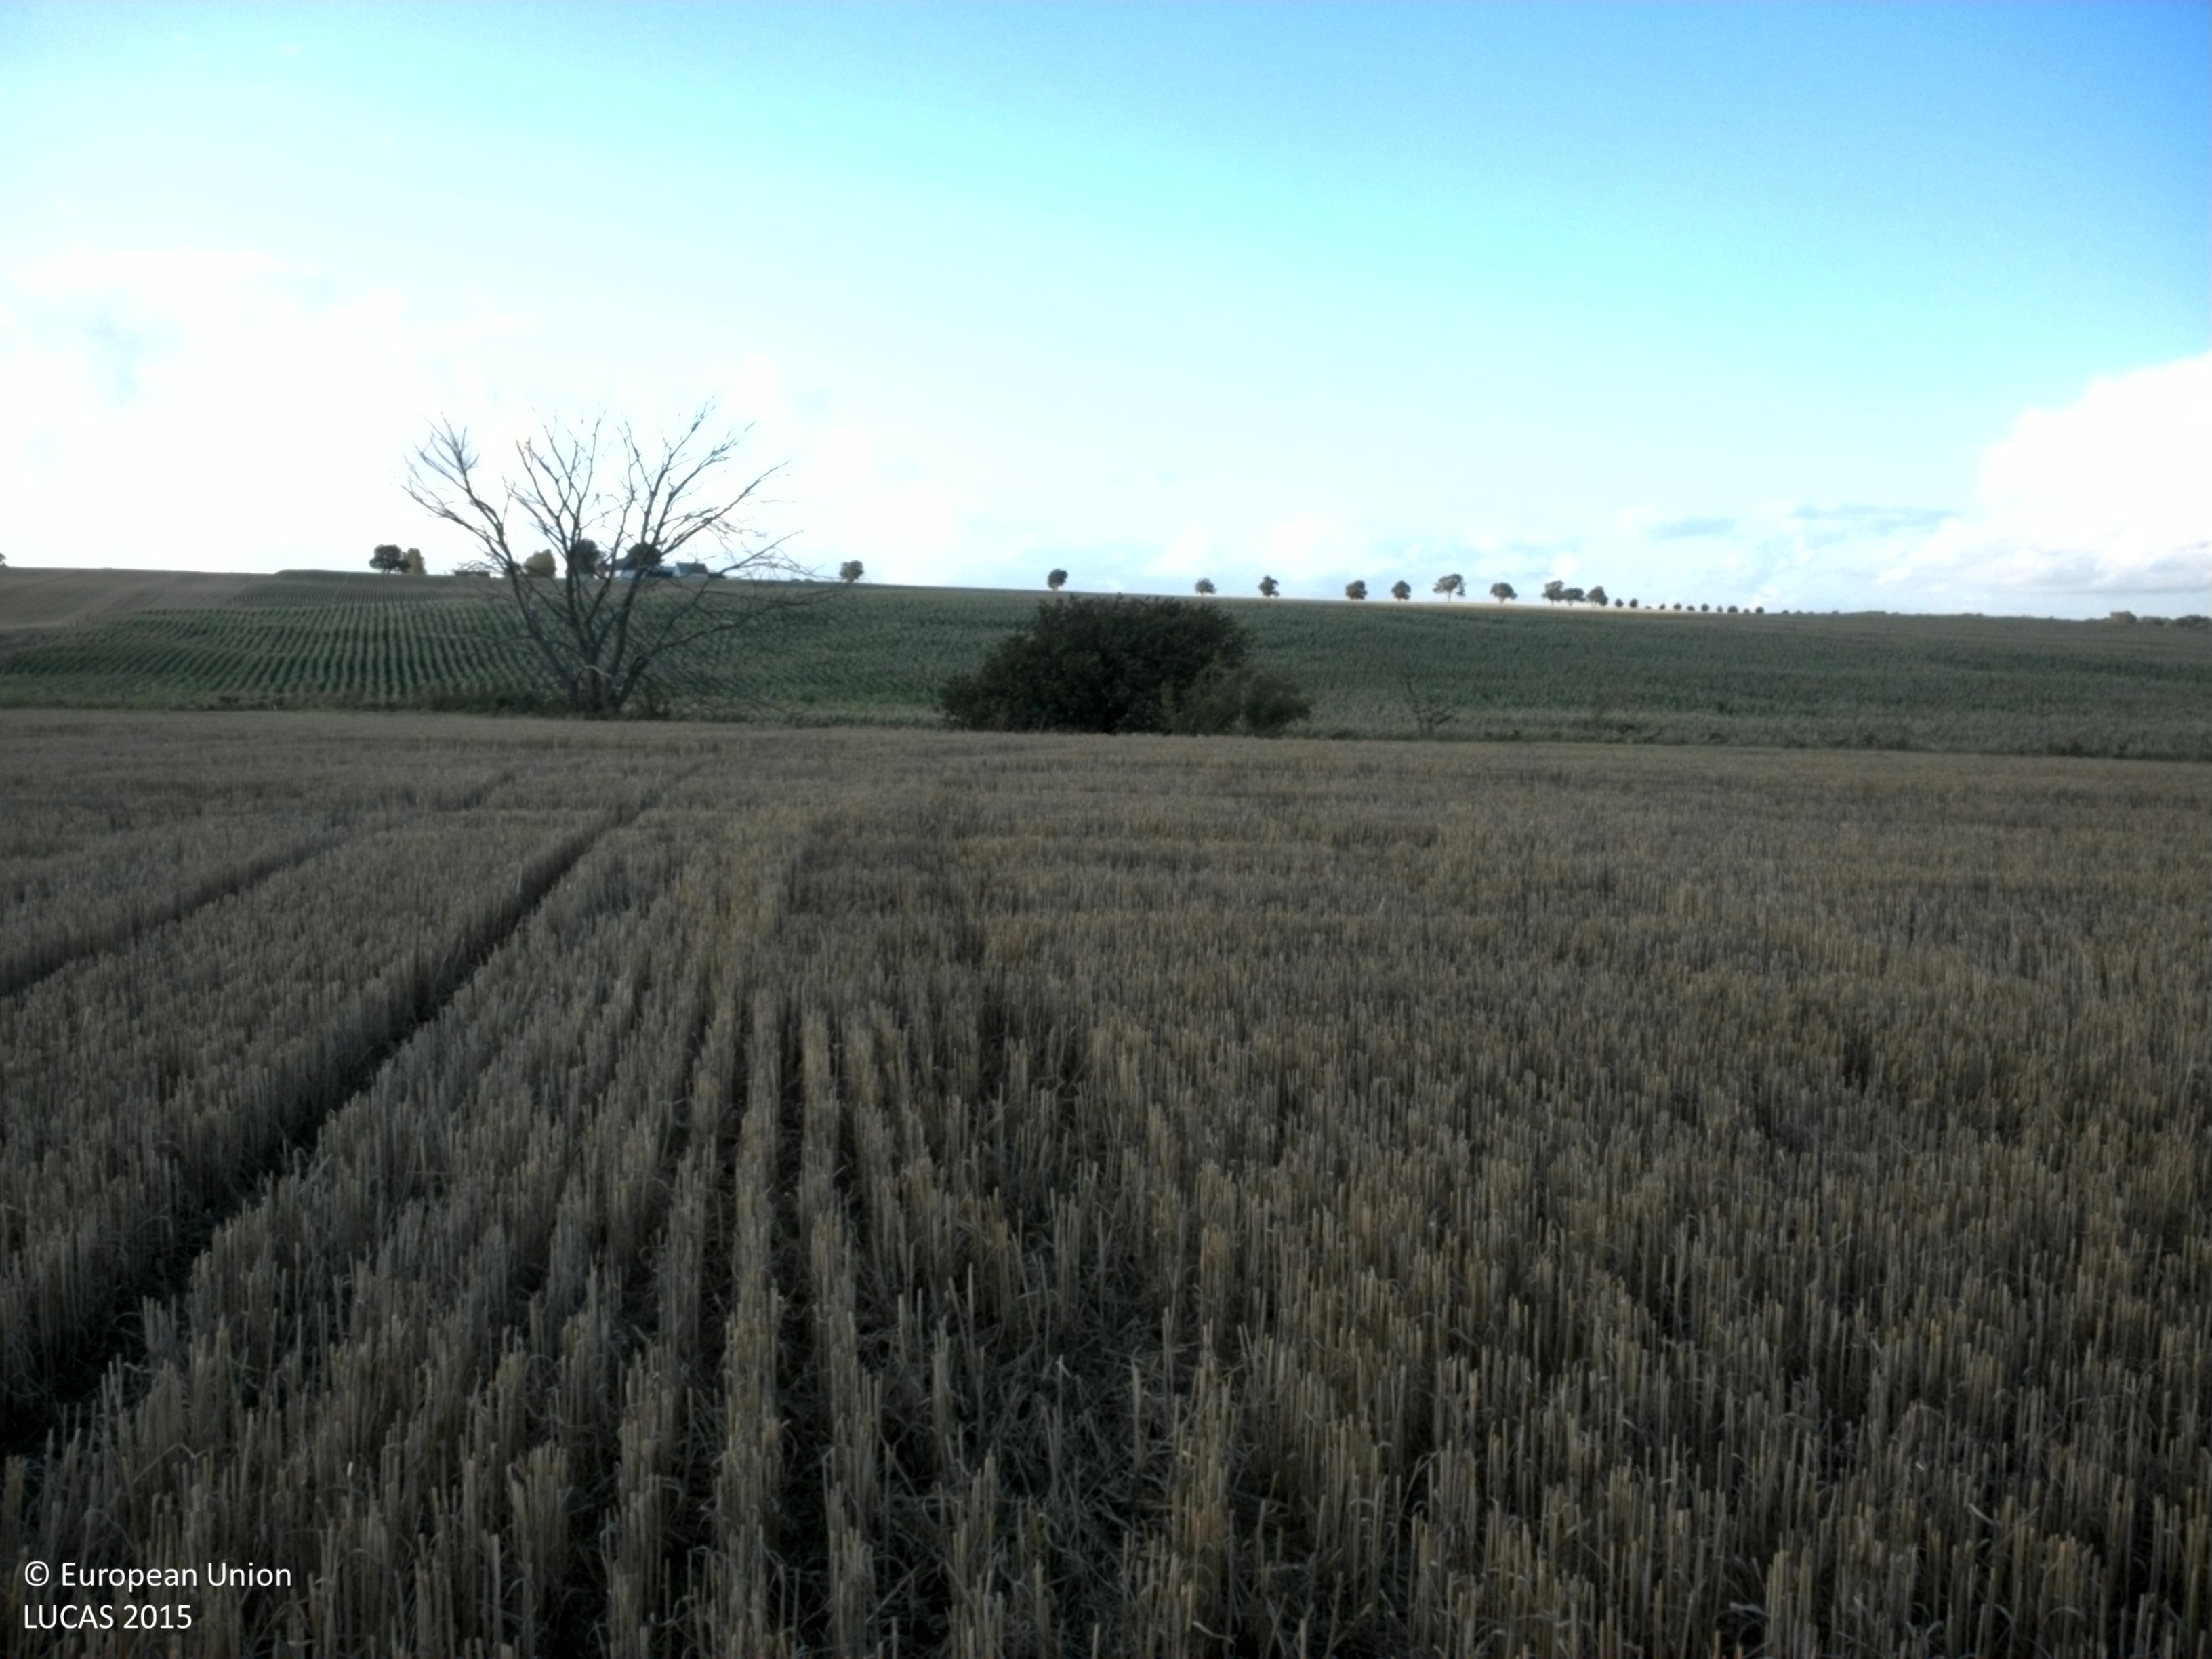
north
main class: Cropland
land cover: Common wheat
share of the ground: 25 - 50 %
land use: Agriculture (excluding fallow land and kitchen gardens)
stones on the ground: < 10 %
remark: Harvested field
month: September
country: SE
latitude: 55.4765
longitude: 14.0330
